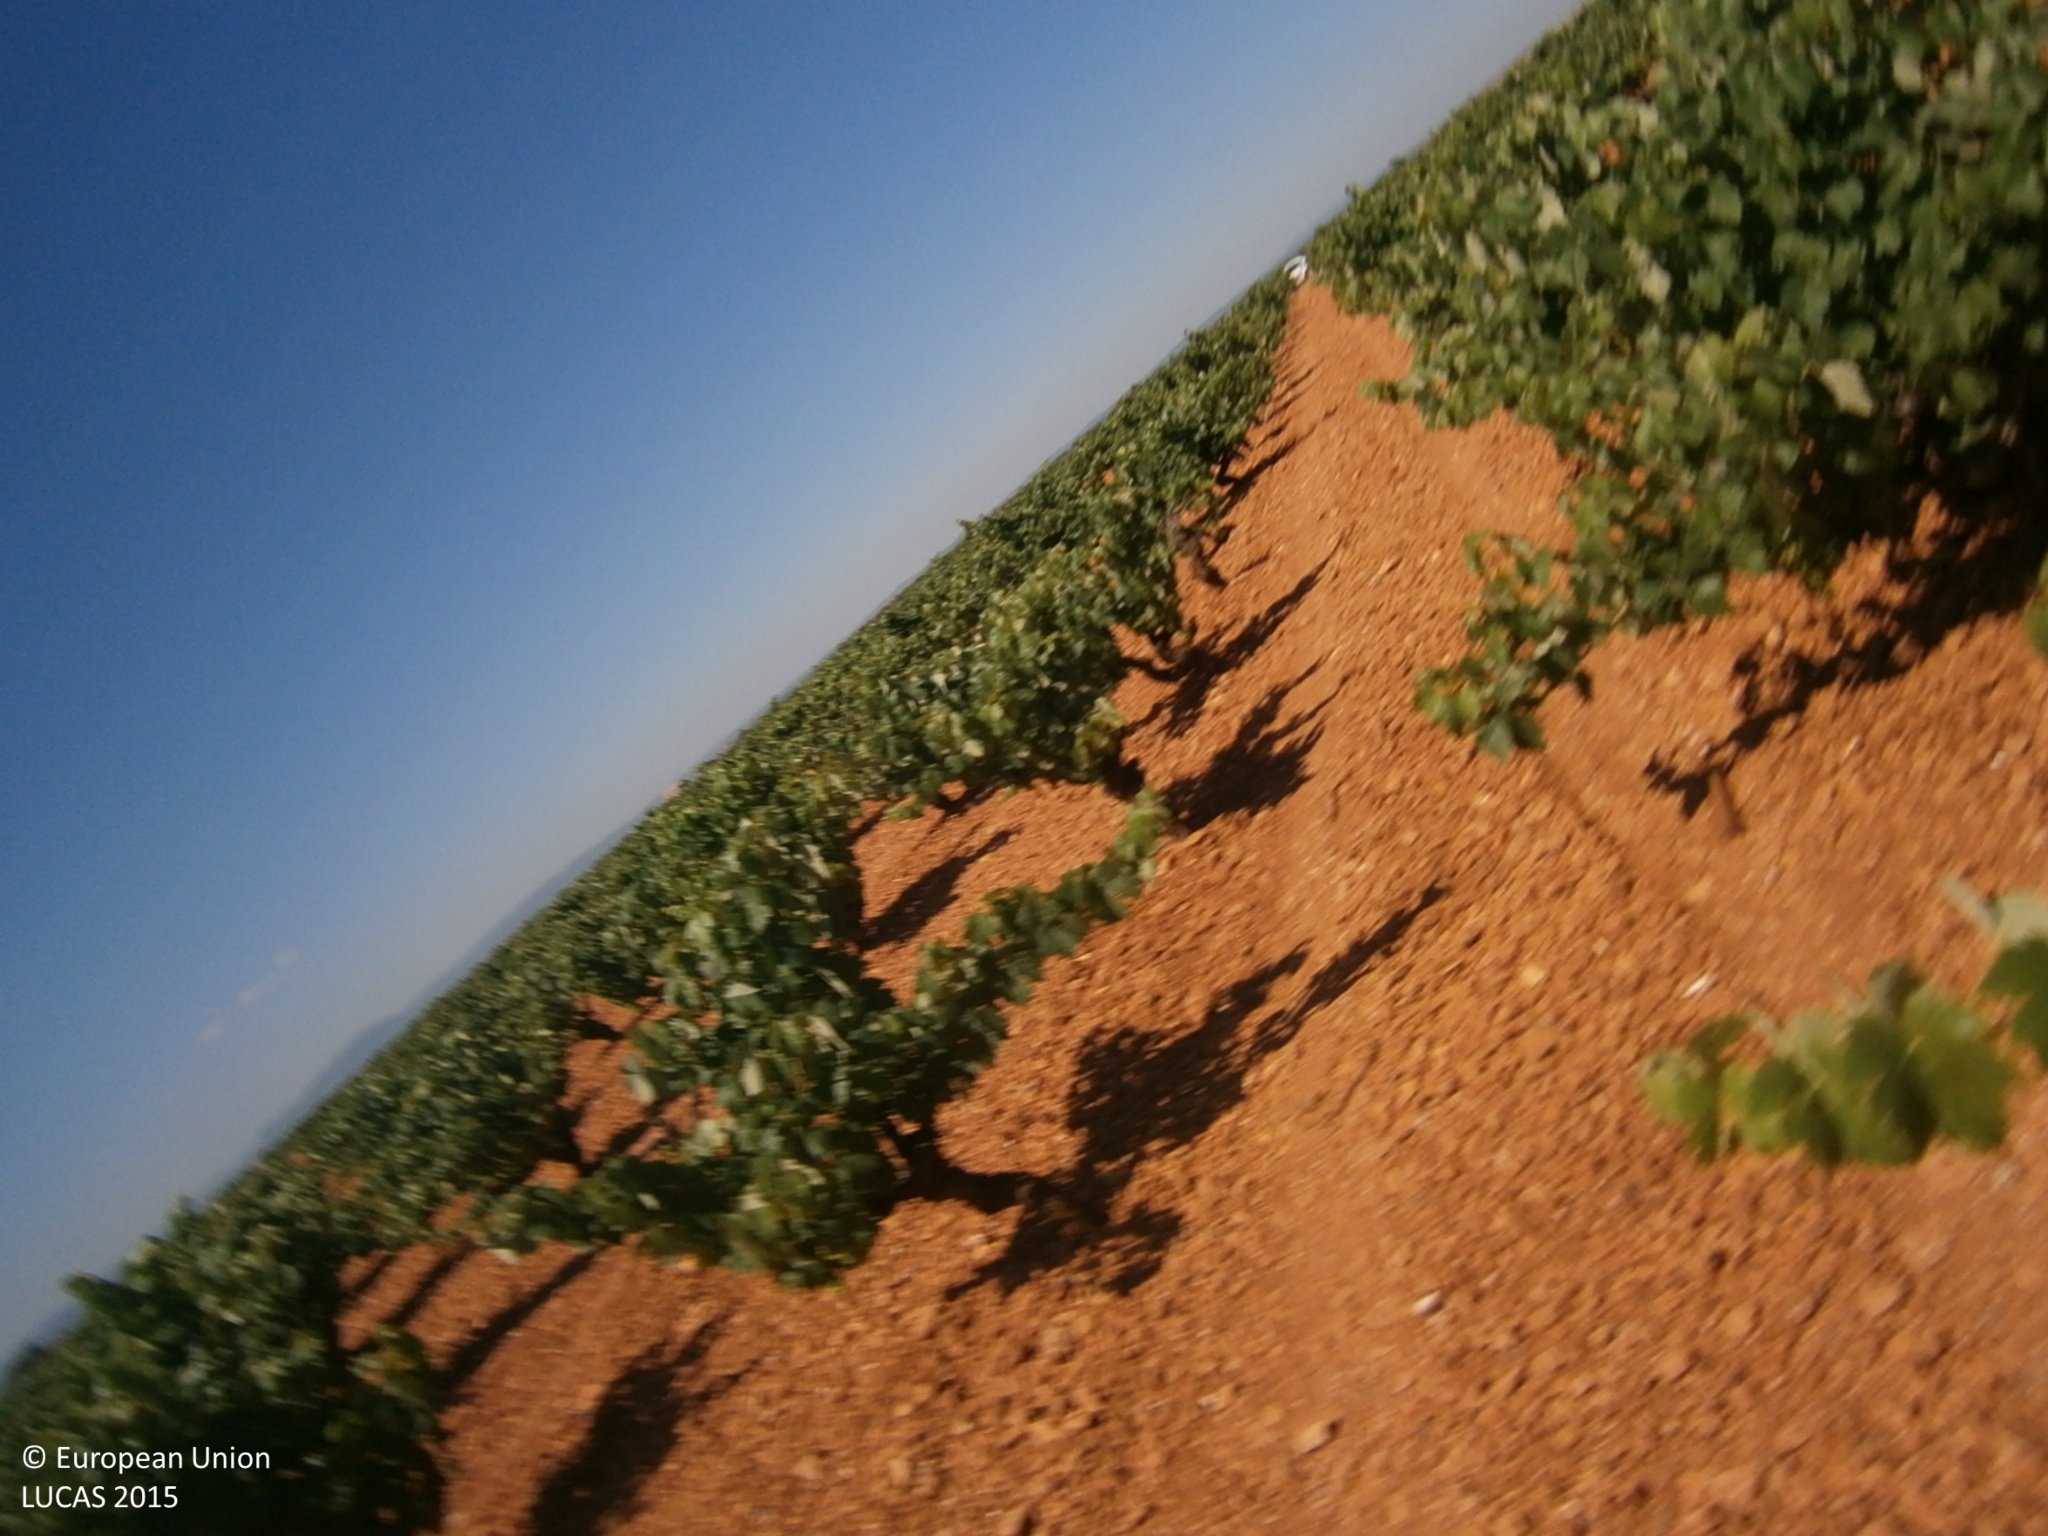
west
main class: Cropland
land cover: Vineyards
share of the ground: 25 - 50 %
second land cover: Other bare soil
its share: > 75 %
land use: Agriculture (excluding fallow land and kitchen gardens)
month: June
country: ES
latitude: 38.7567
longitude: -6.6664
